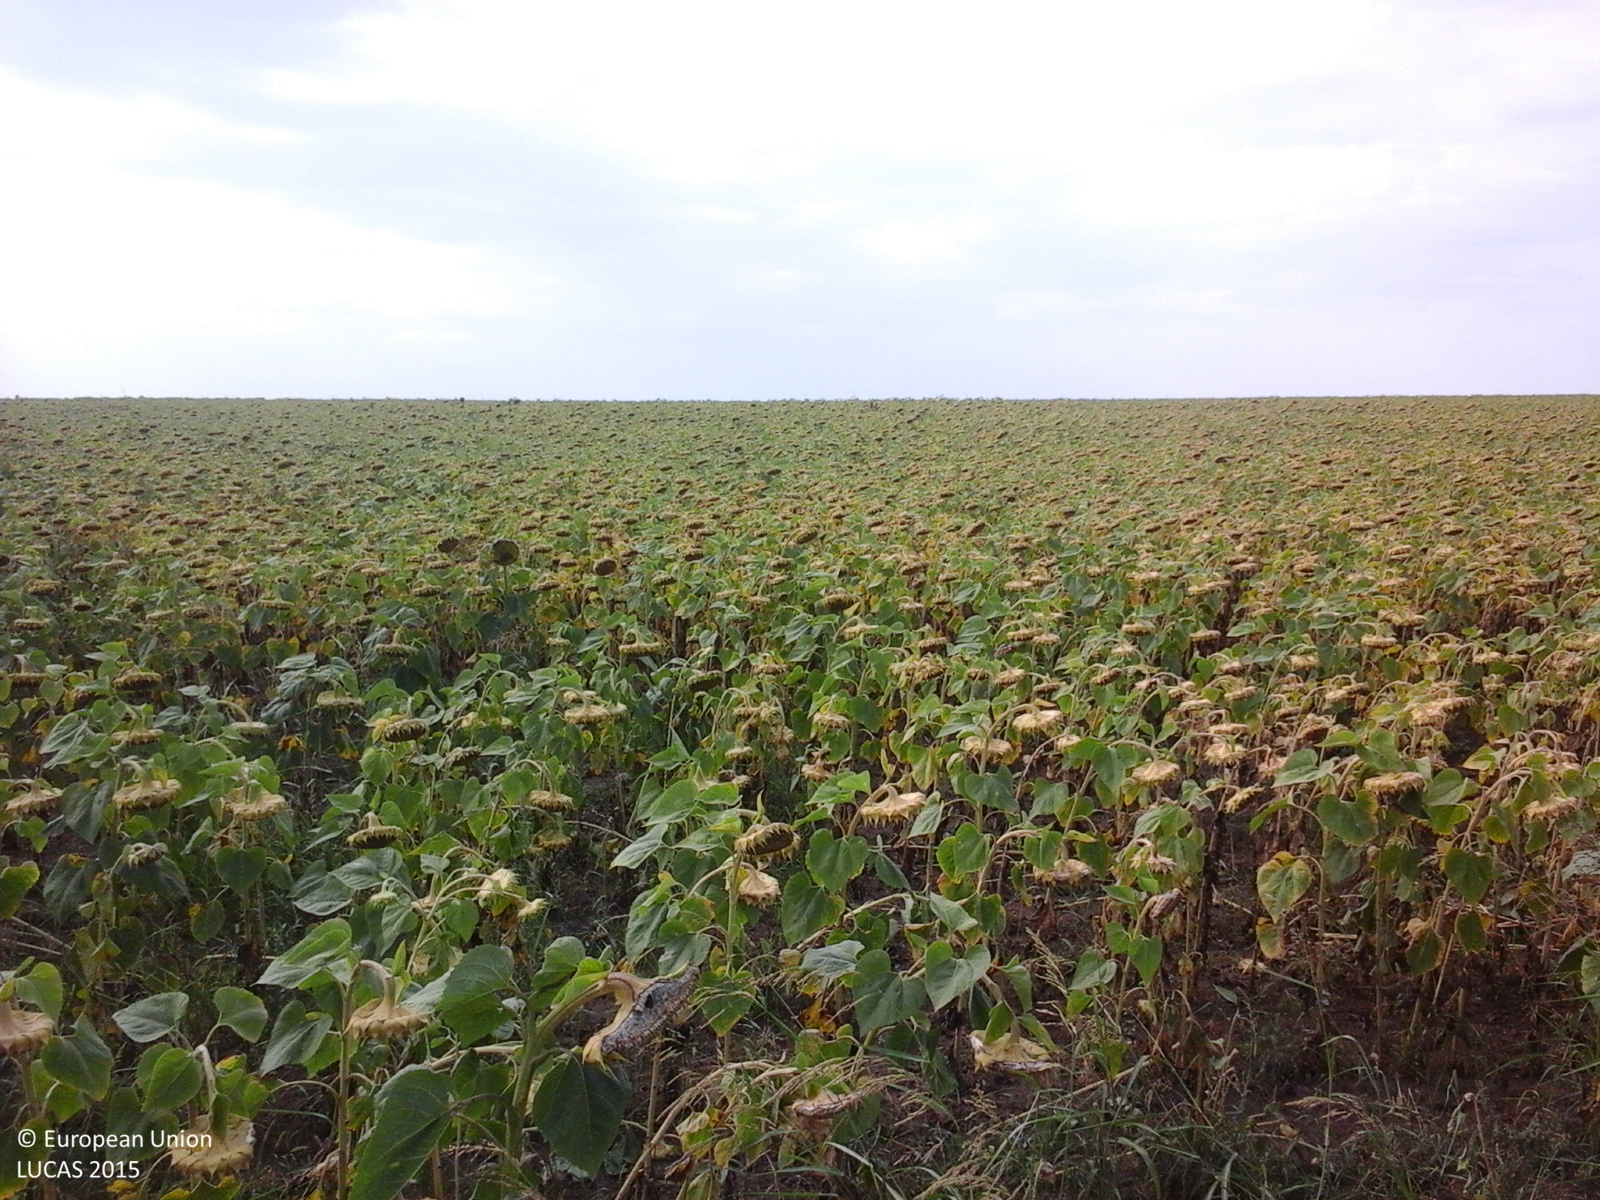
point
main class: Cropland
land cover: Sunflower
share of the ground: > 75 %
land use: Agriculture (excluding fallow land and kitchen gardens)
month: August
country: RO
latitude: 44.1932
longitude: 28.3442
